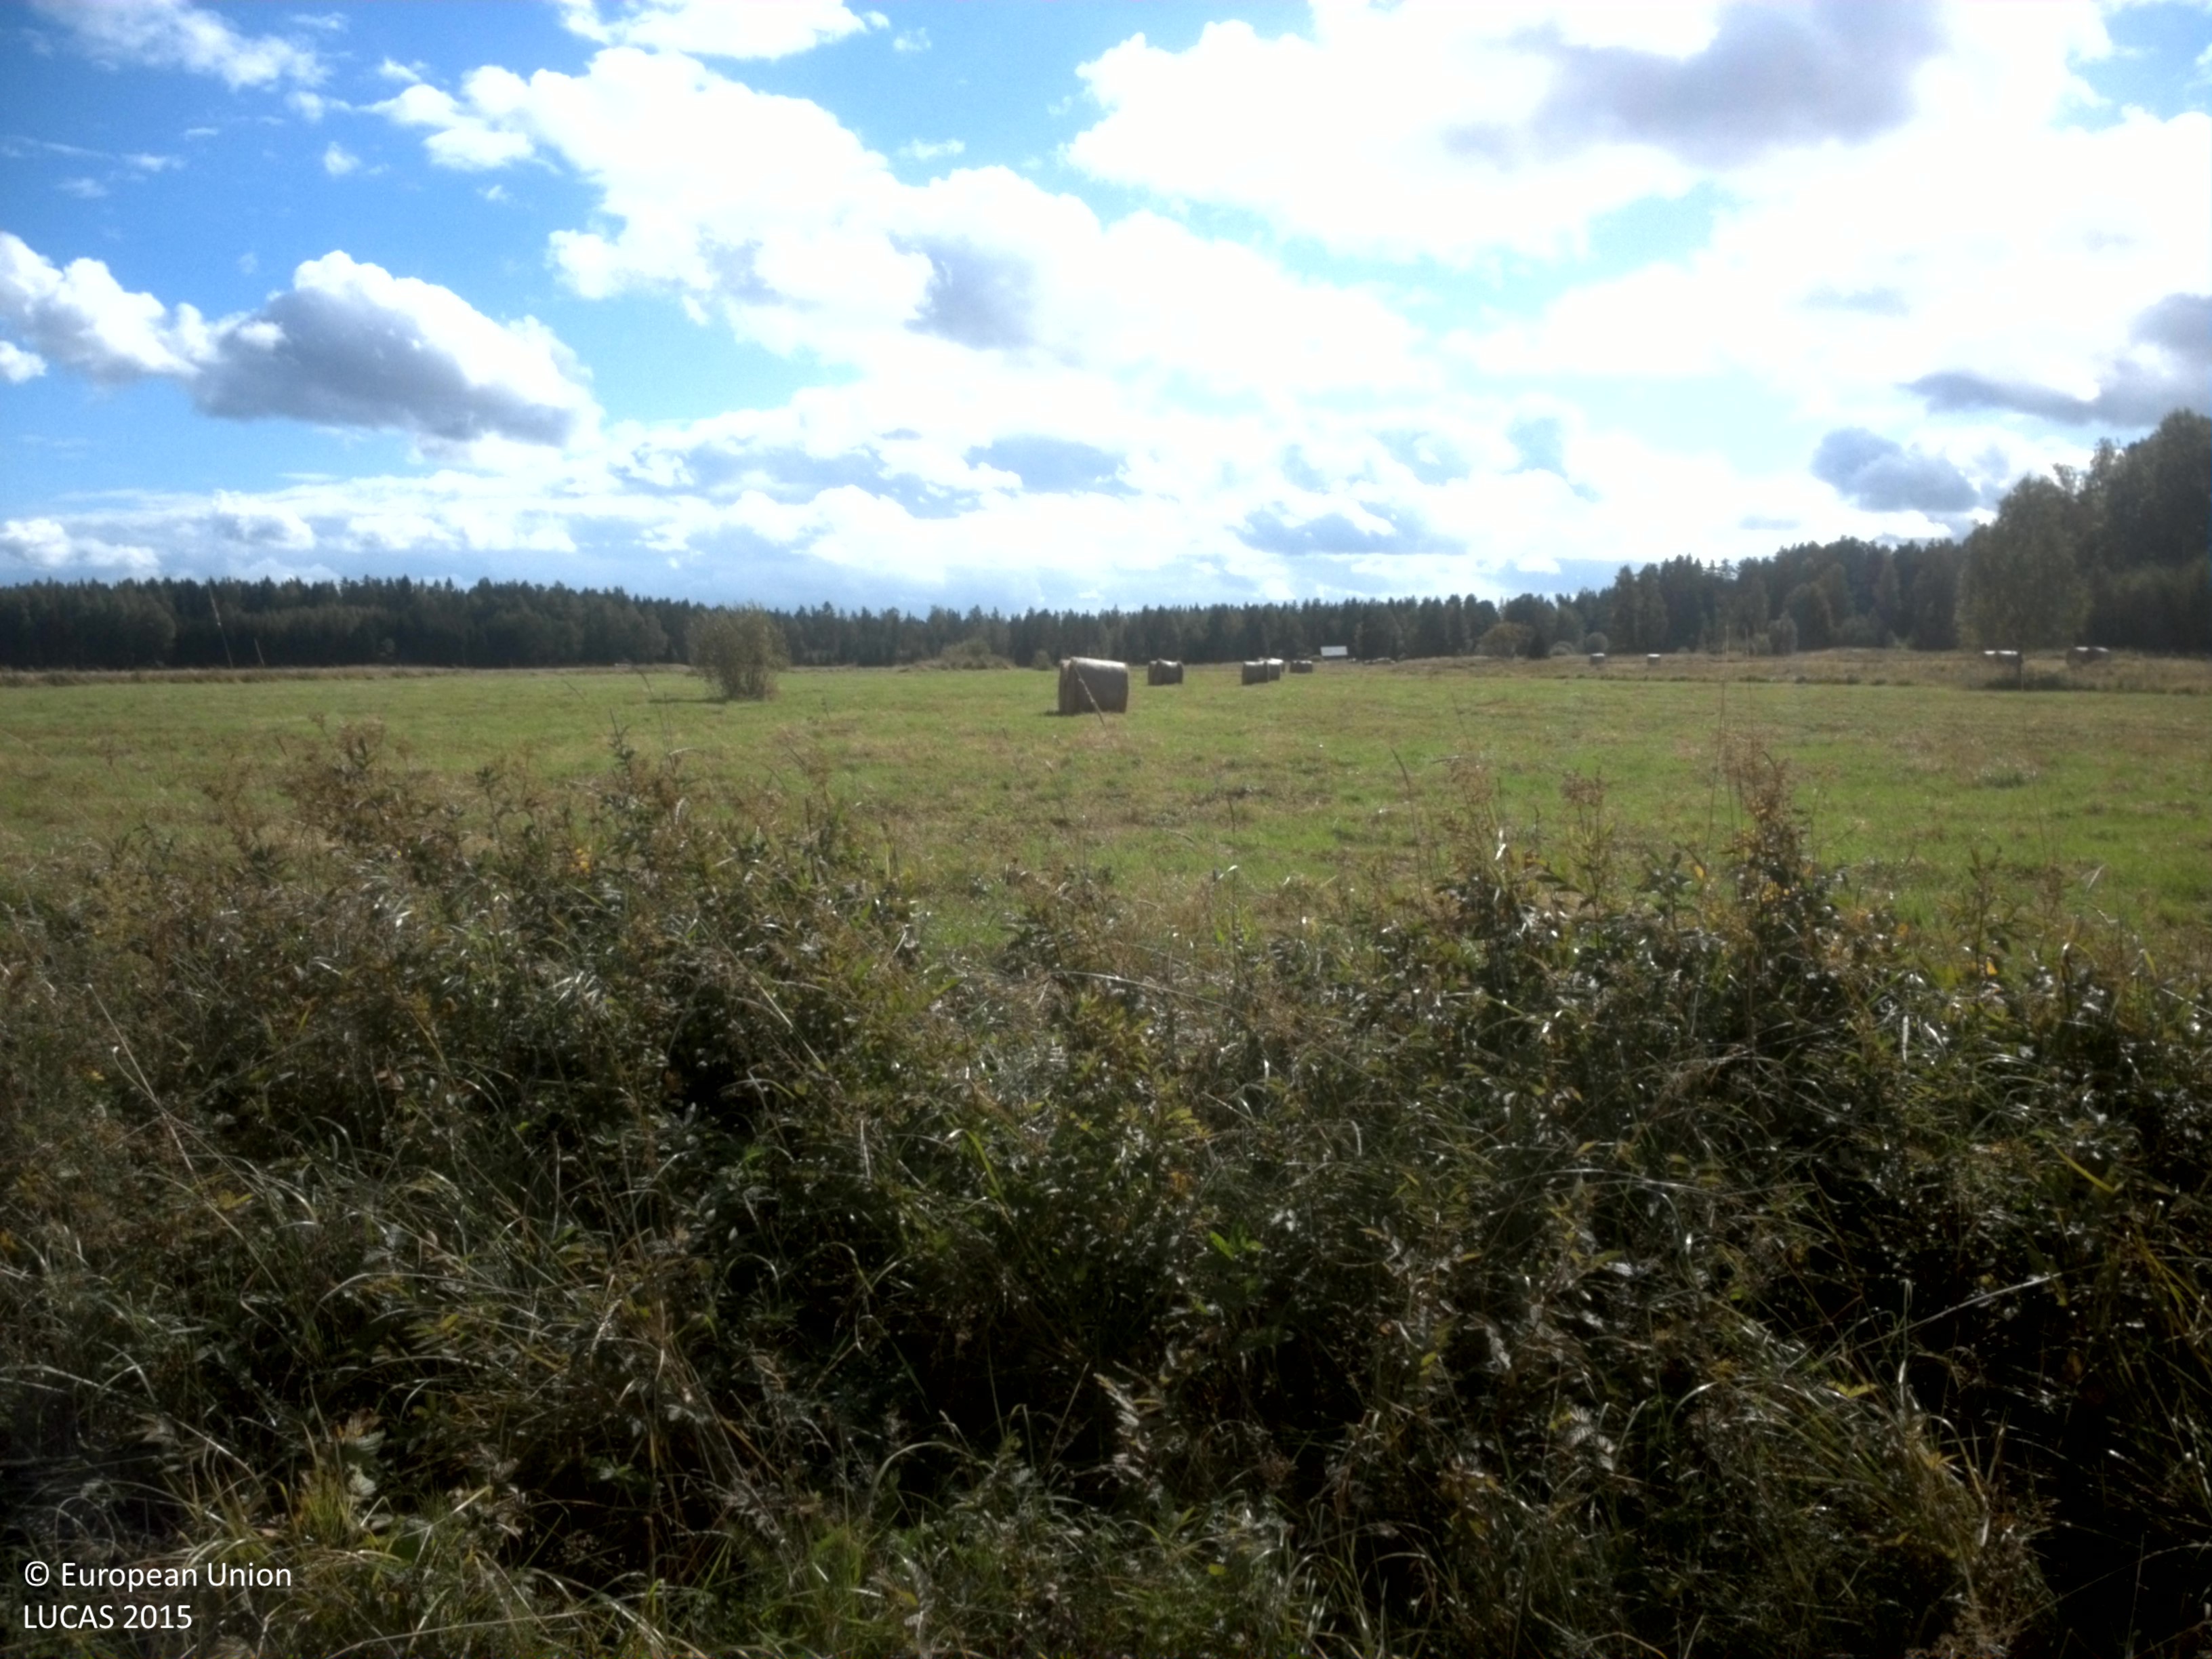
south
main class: Cropland
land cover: Oats
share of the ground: > 75 %
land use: Agriculture (excluding fallow land and kitchen gardens)
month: August
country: SE
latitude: 59.4702
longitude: 15.6919
